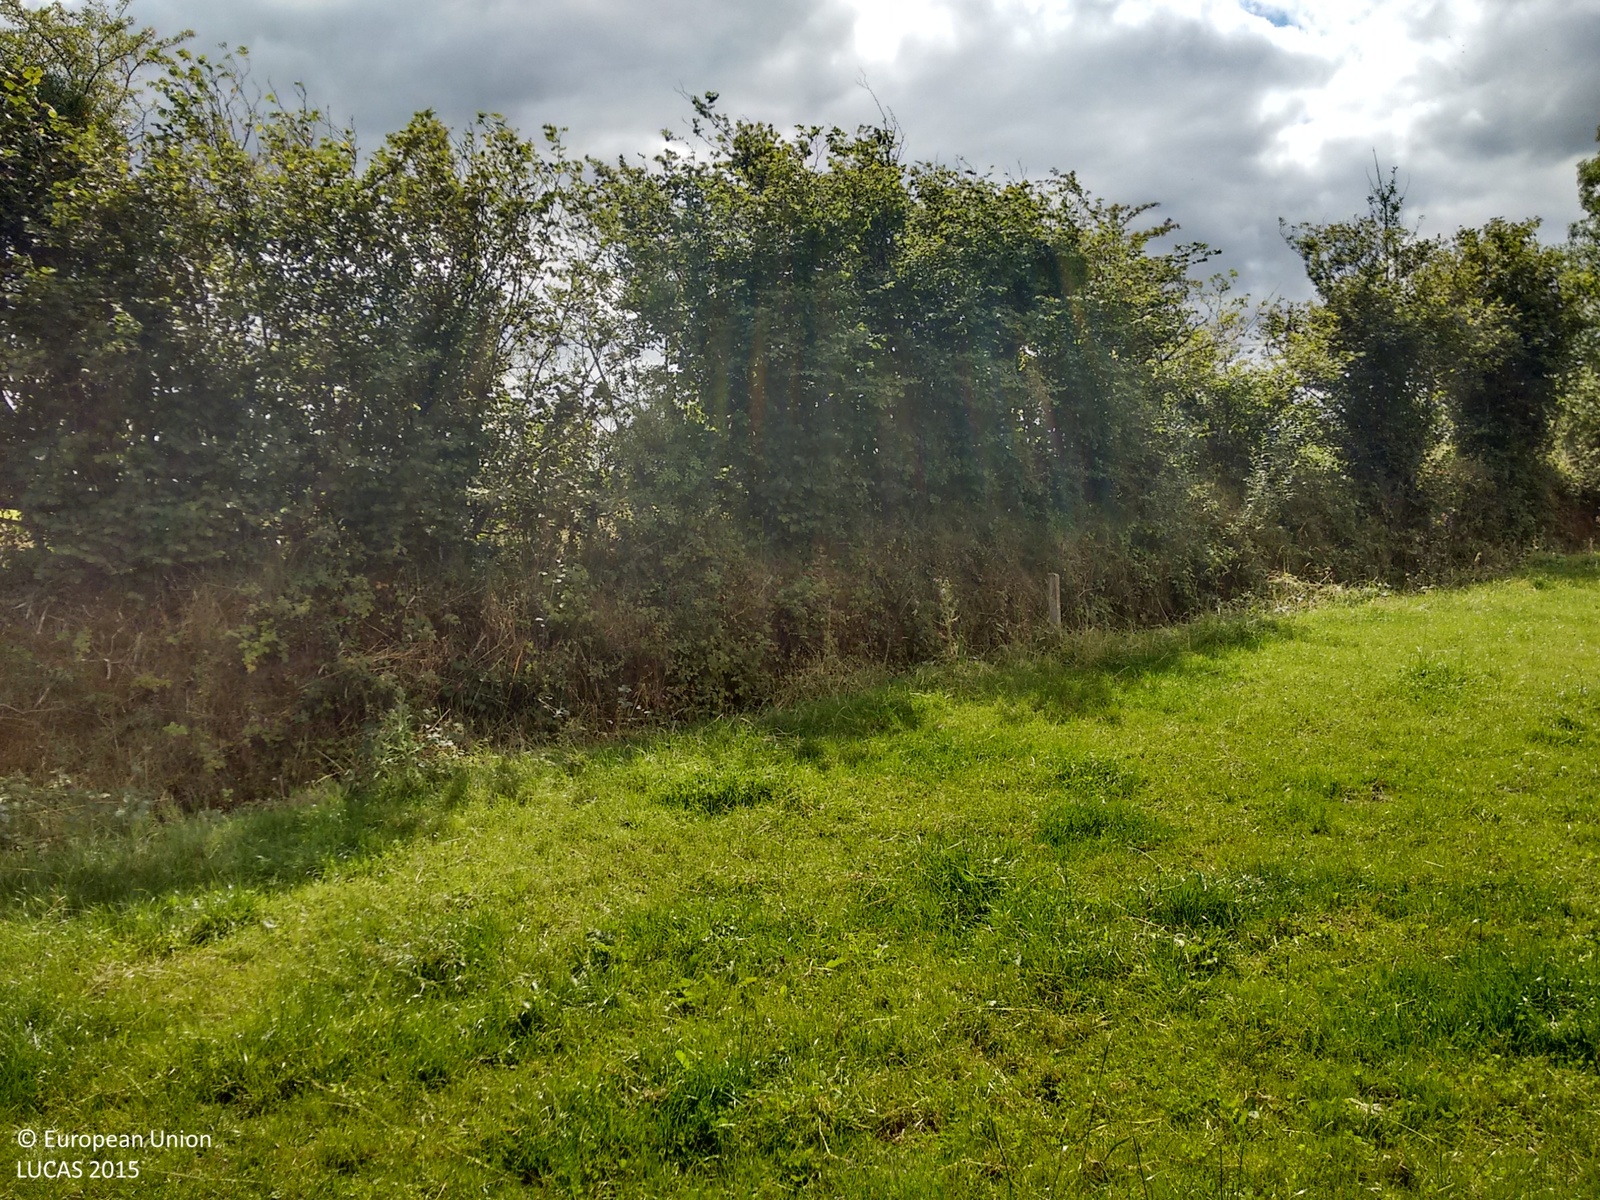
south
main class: Grassland
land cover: Grassland without tree/shrub cover
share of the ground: > 75 %
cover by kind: herbaceous plants 100 %
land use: Agriculture (excluding fallow land and kitchen gardens)
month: August
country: IE
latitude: 52.8906
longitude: -7.8424
